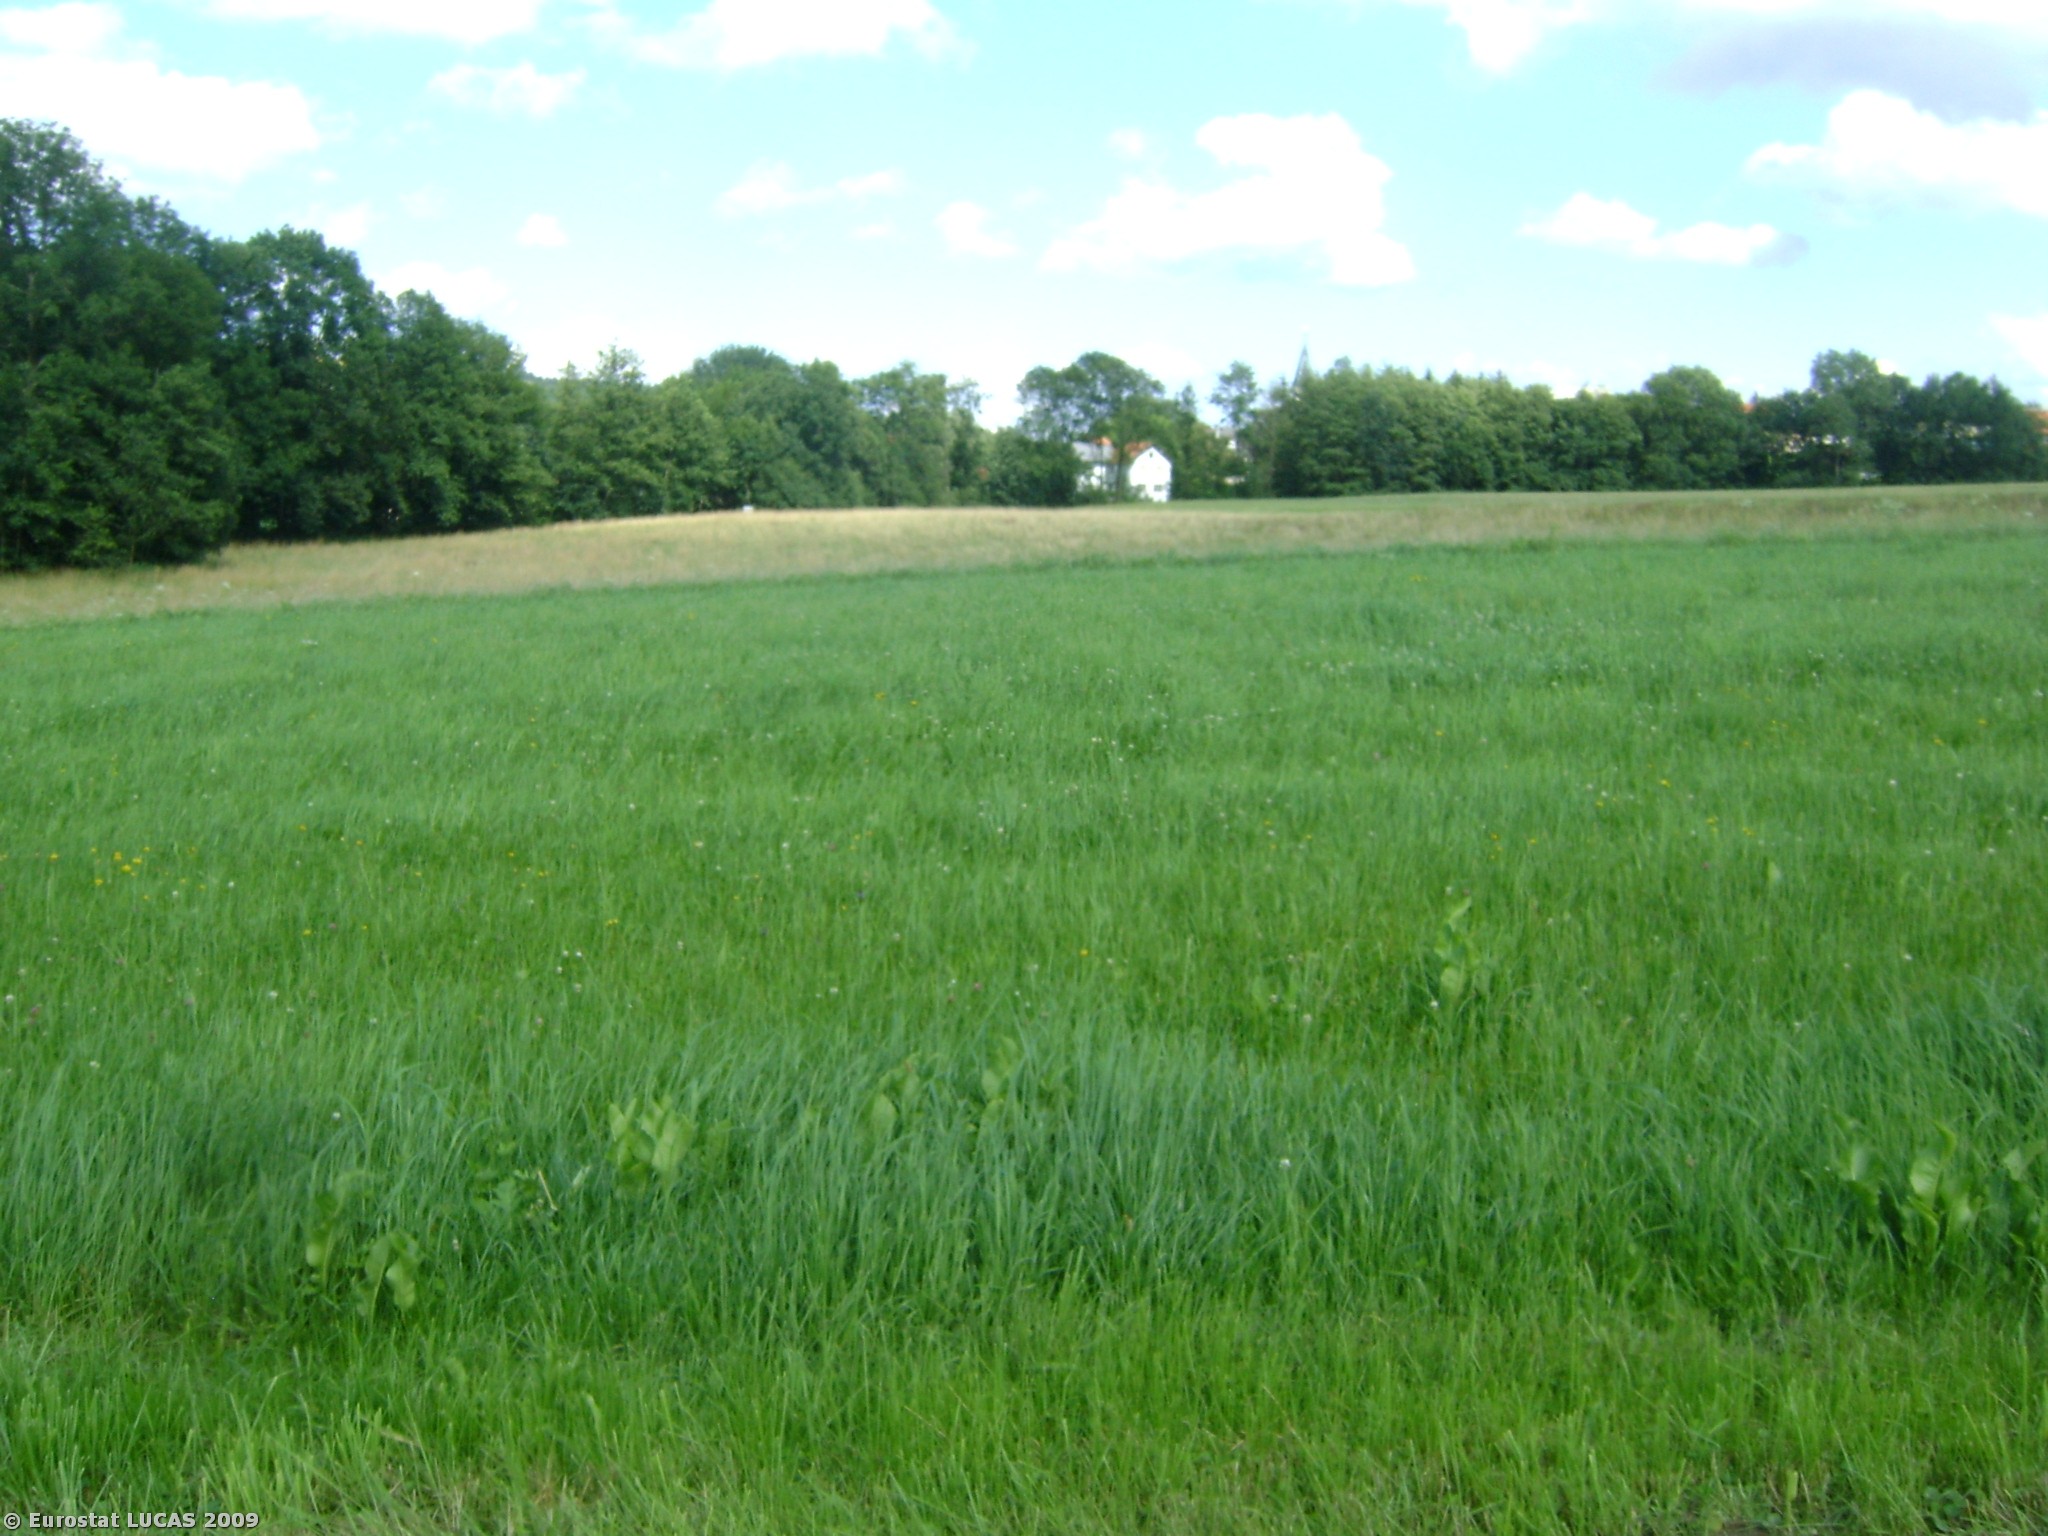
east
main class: Grassland
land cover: Grassland without tree/shrub cover
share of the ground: > 75 %
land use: Agriculture (excluding fallow land and kitchen gardens)
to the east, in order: Grassland without tree/shrub cover; Paved roads, cycling and walking lanes; Grassland without tree/shrub cover; Broadleaved woodland
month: July
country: AT
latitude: 48.2388
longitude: 13.5405
